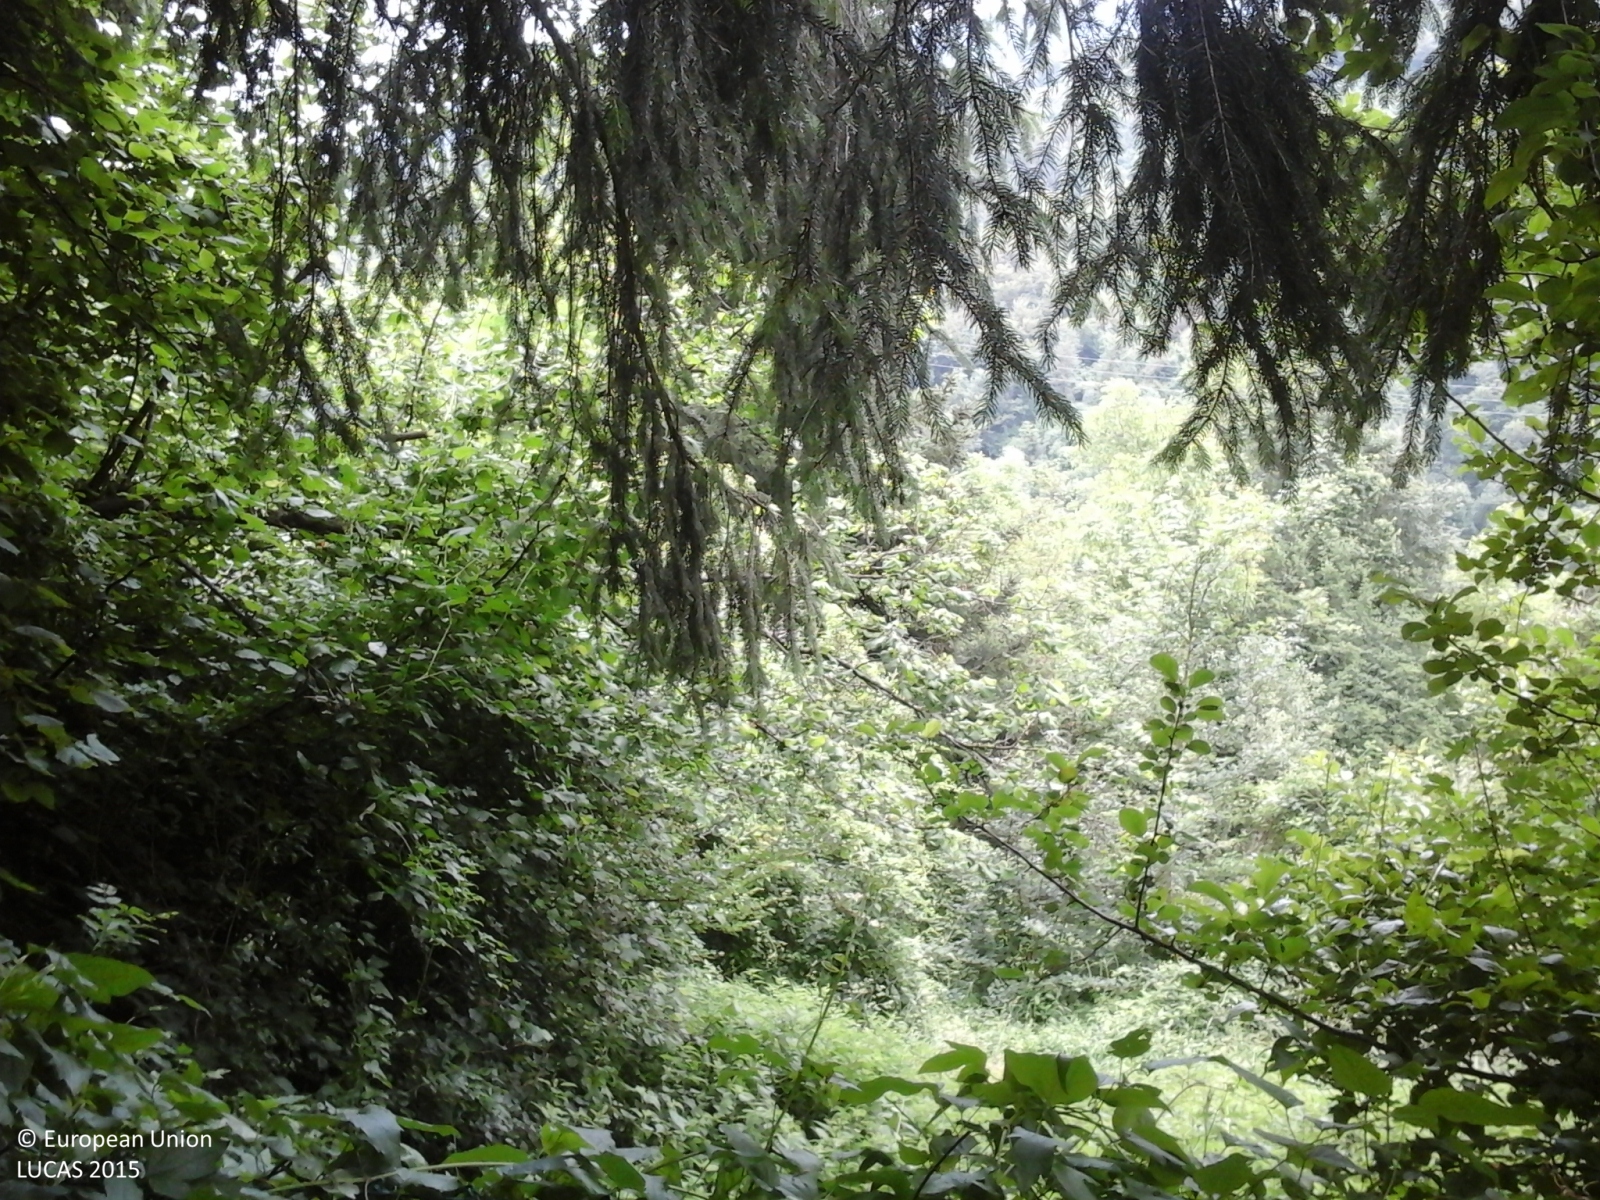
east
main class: Woodland
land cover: Broadleaved woodland
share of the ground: > 75 %
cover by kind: broadleaved forest trees 80 %, coniferous forest trees 20 %
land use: Forestry
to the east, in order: Broadleaved woodland; Grassland without tree/shrub cover; Broadleaved woodland; Inland fresh running water
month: June
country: IT
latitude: 44.5662
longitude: 9.6105
